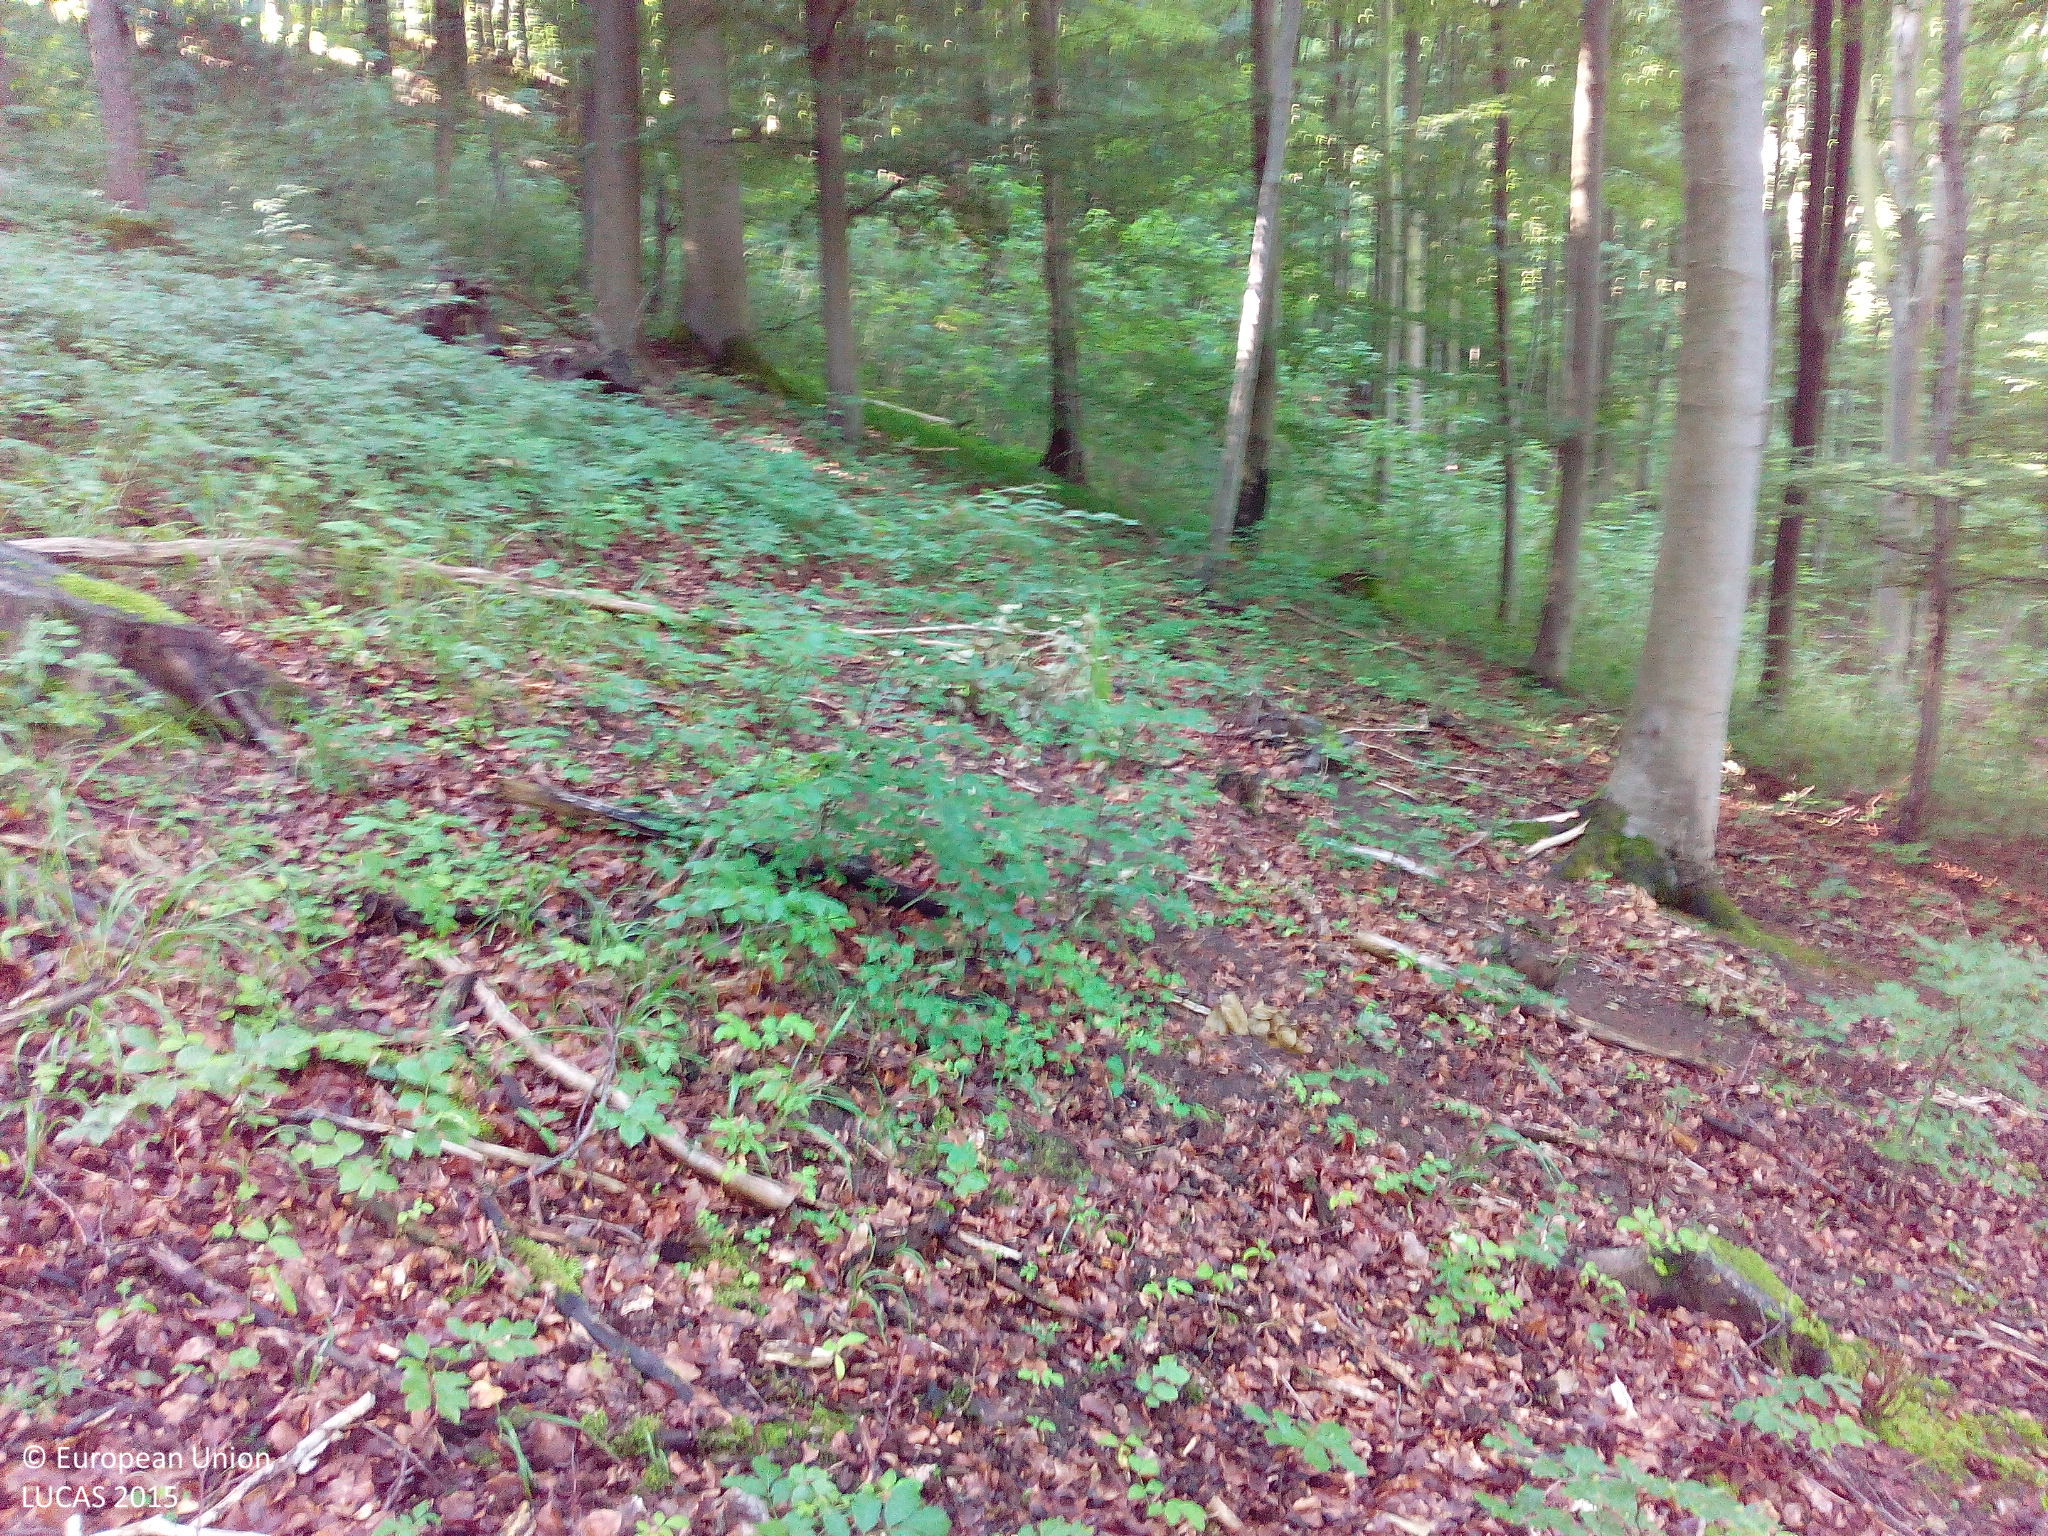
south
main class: Woodland
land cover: Broadleaved woodland
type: beech forest
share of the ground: > 75 %
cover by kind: broadleaved forest trees 100 %
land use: Forestry
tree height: > 5 m
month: July
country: DE
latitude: 50.6337
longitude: 9.9293
